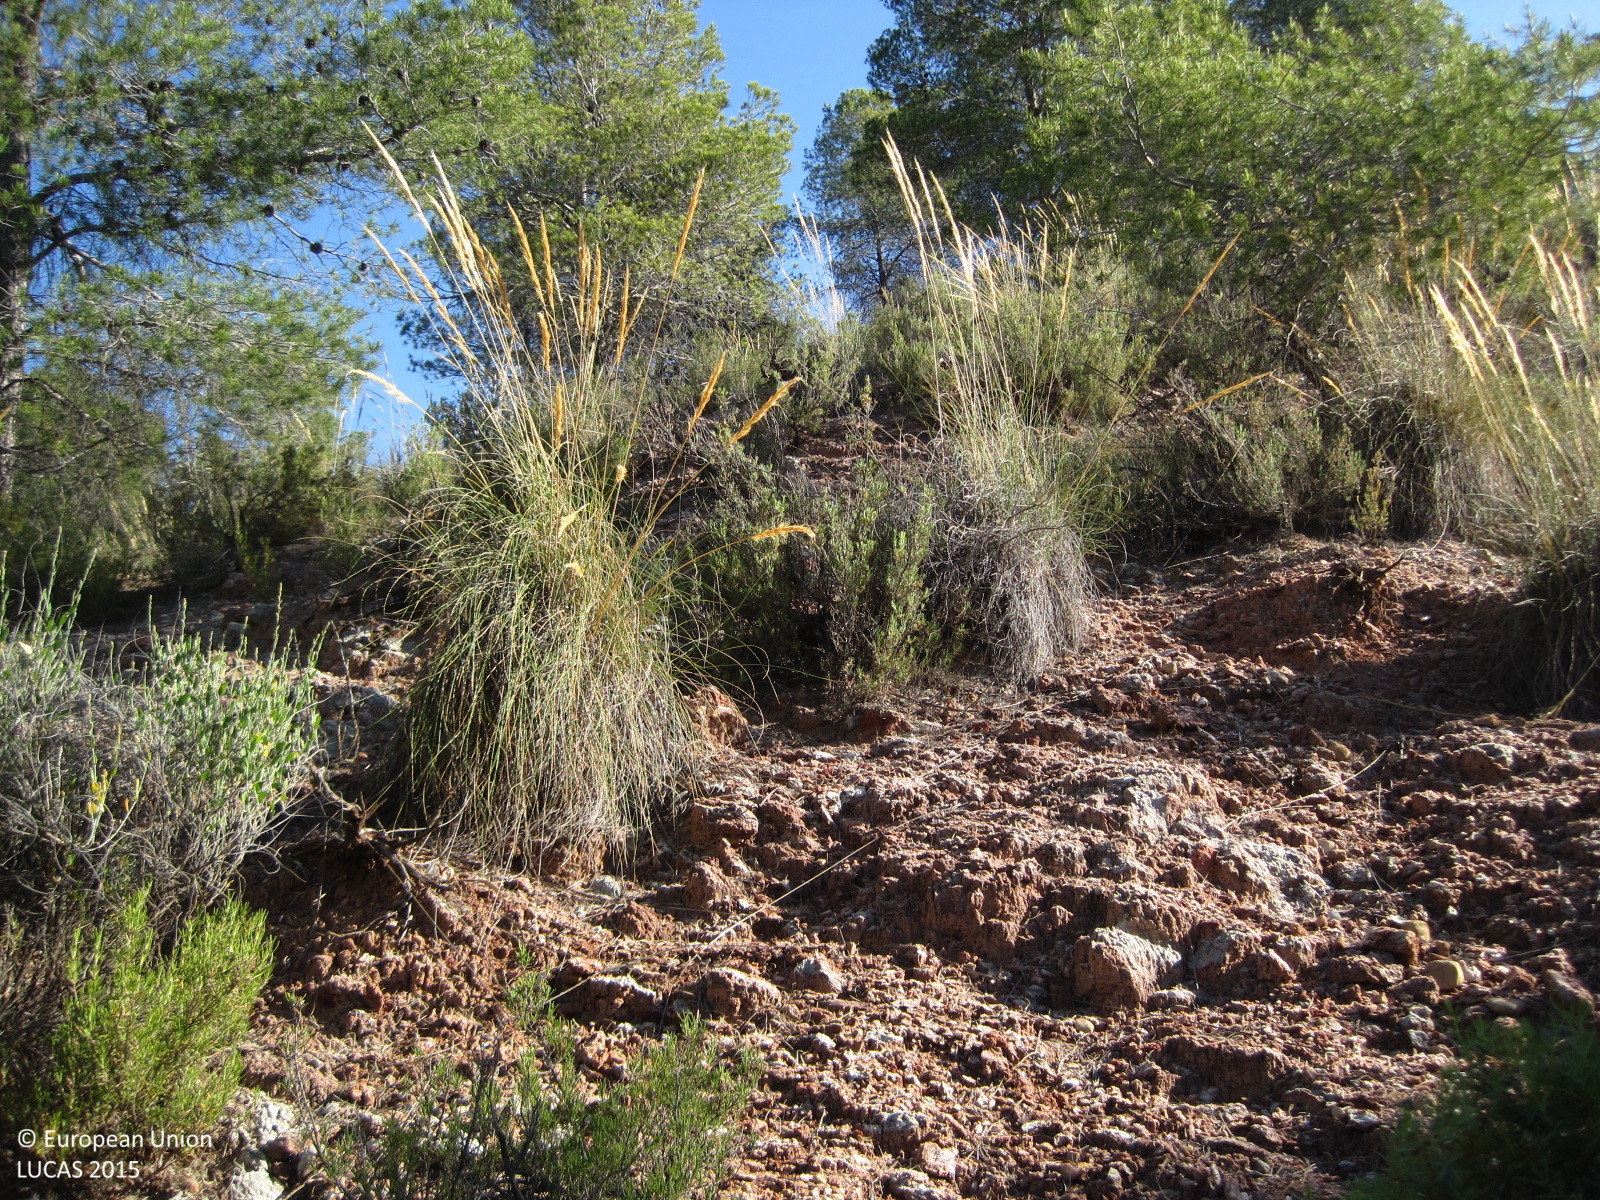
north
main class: Woodland
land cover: Pine dominated coniferous woodland
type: coniferous forest of the mediterranean region
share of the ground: 10 - 25 %
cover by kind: shrubs 30 %, herbaceous plants 25 %, unconsolidated bare surface 25 %, coniferous forest trees 20 %
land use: Forestry
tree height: > 5 m
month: June
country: ES
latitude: 39.2766
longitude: -1.0457
